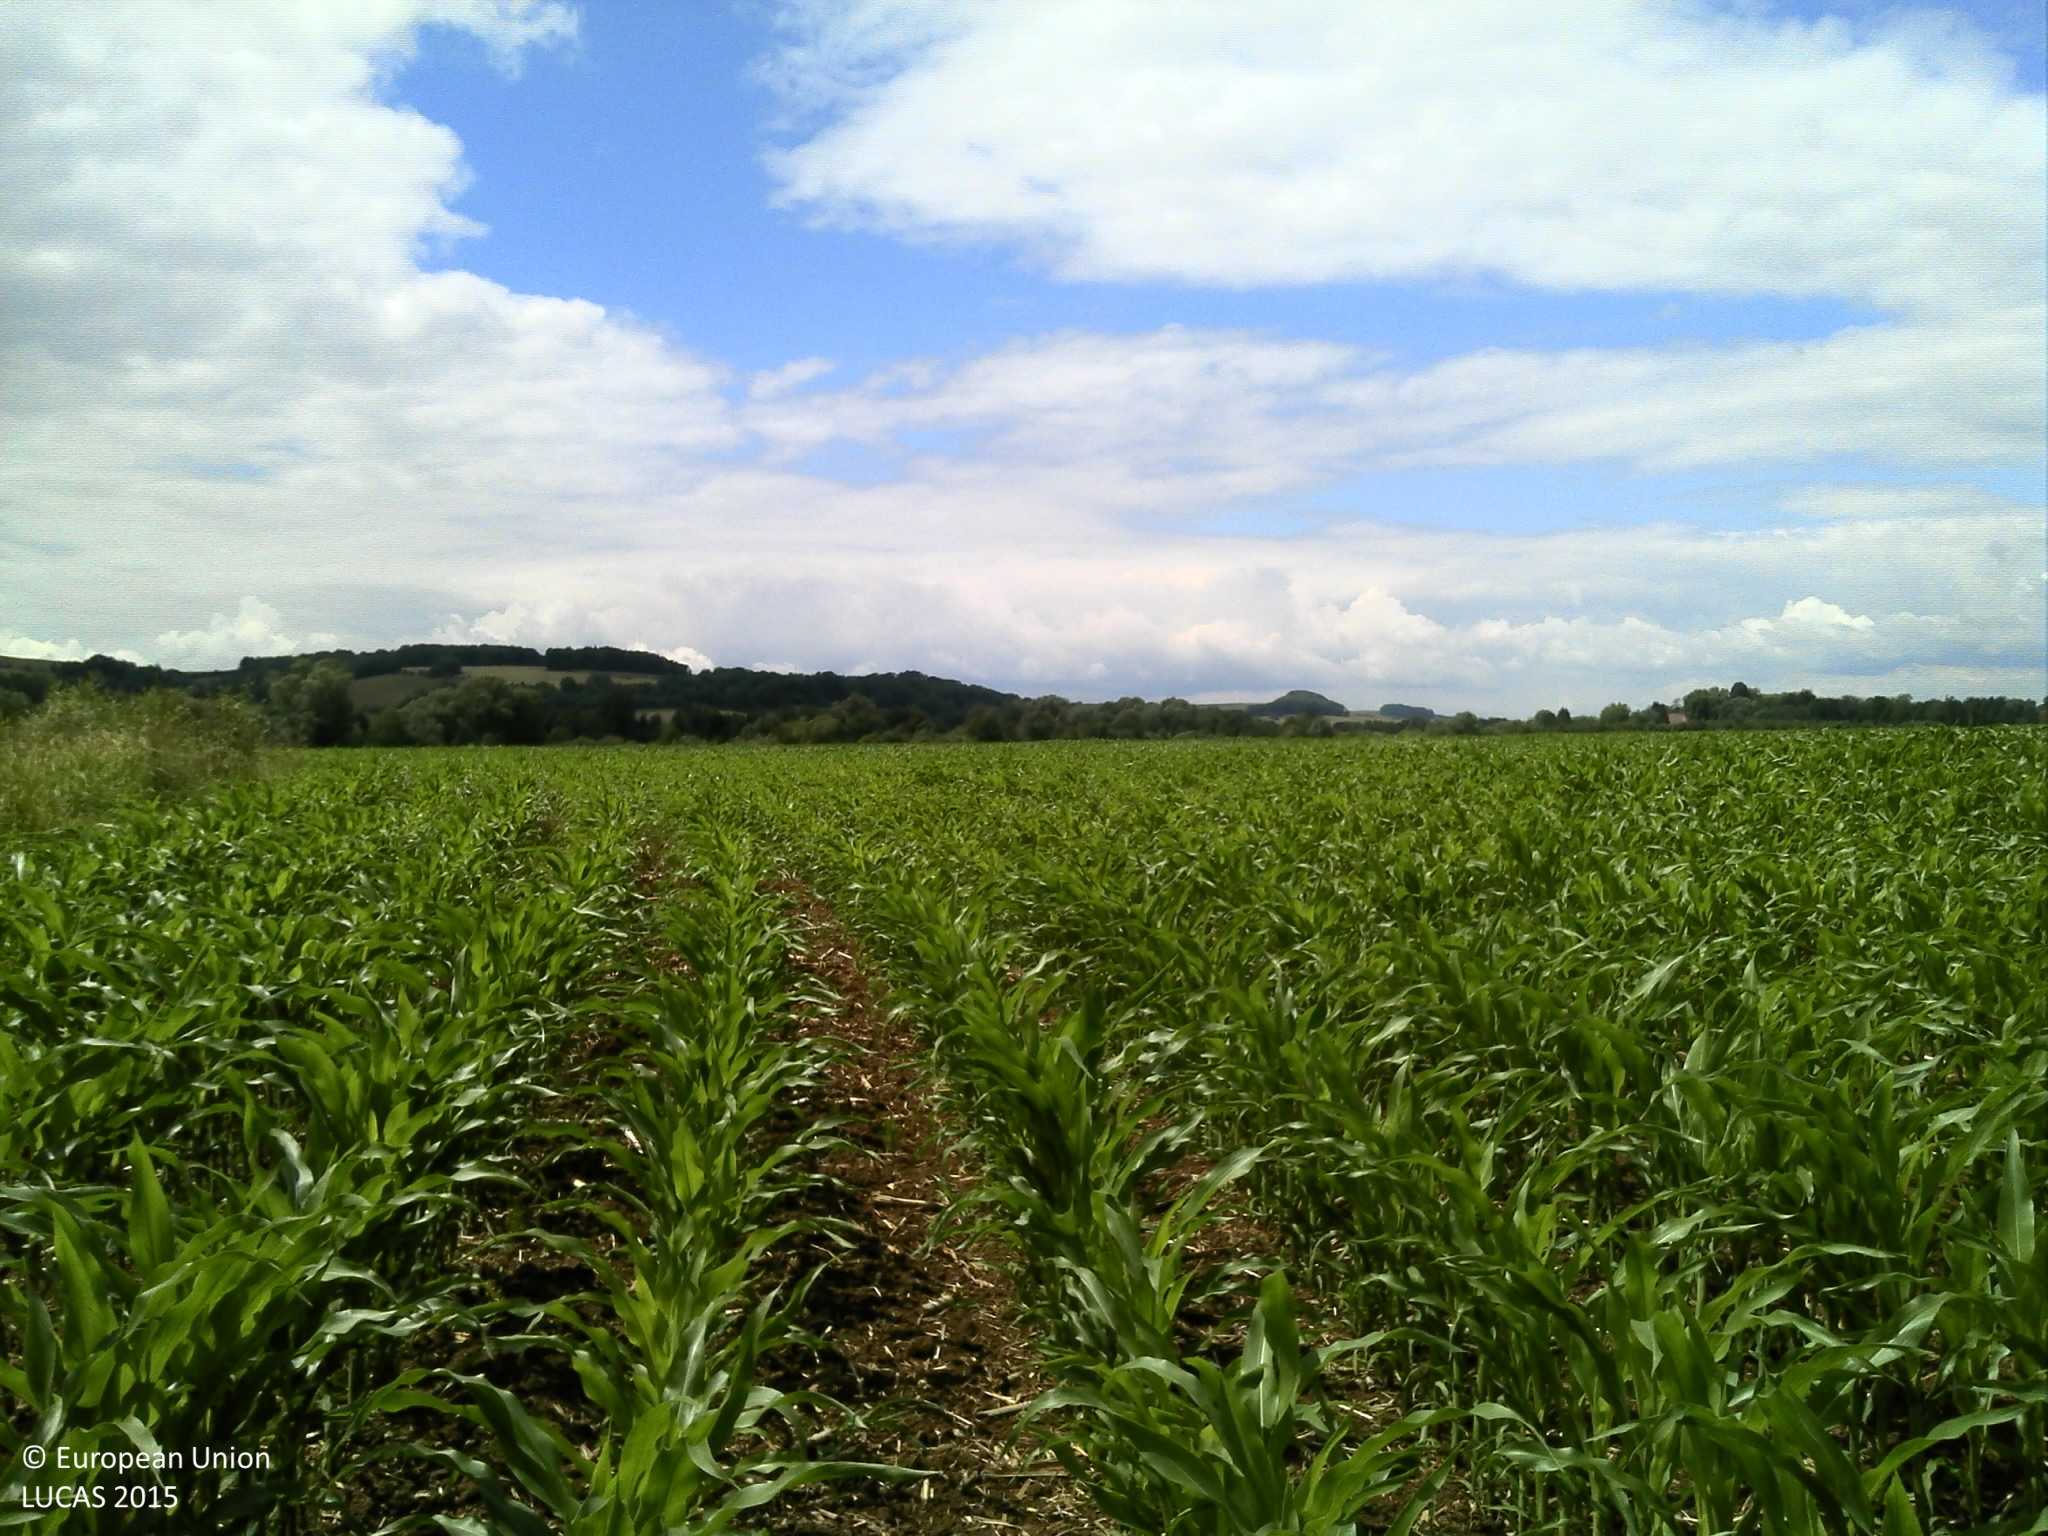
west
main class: Cropland
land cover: Maize
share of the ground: 50 - 75 %
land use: Agriculture (excluding fallow land and kitchen gardens)
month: June
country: FR
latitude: 49.6600
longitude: 4.9964
